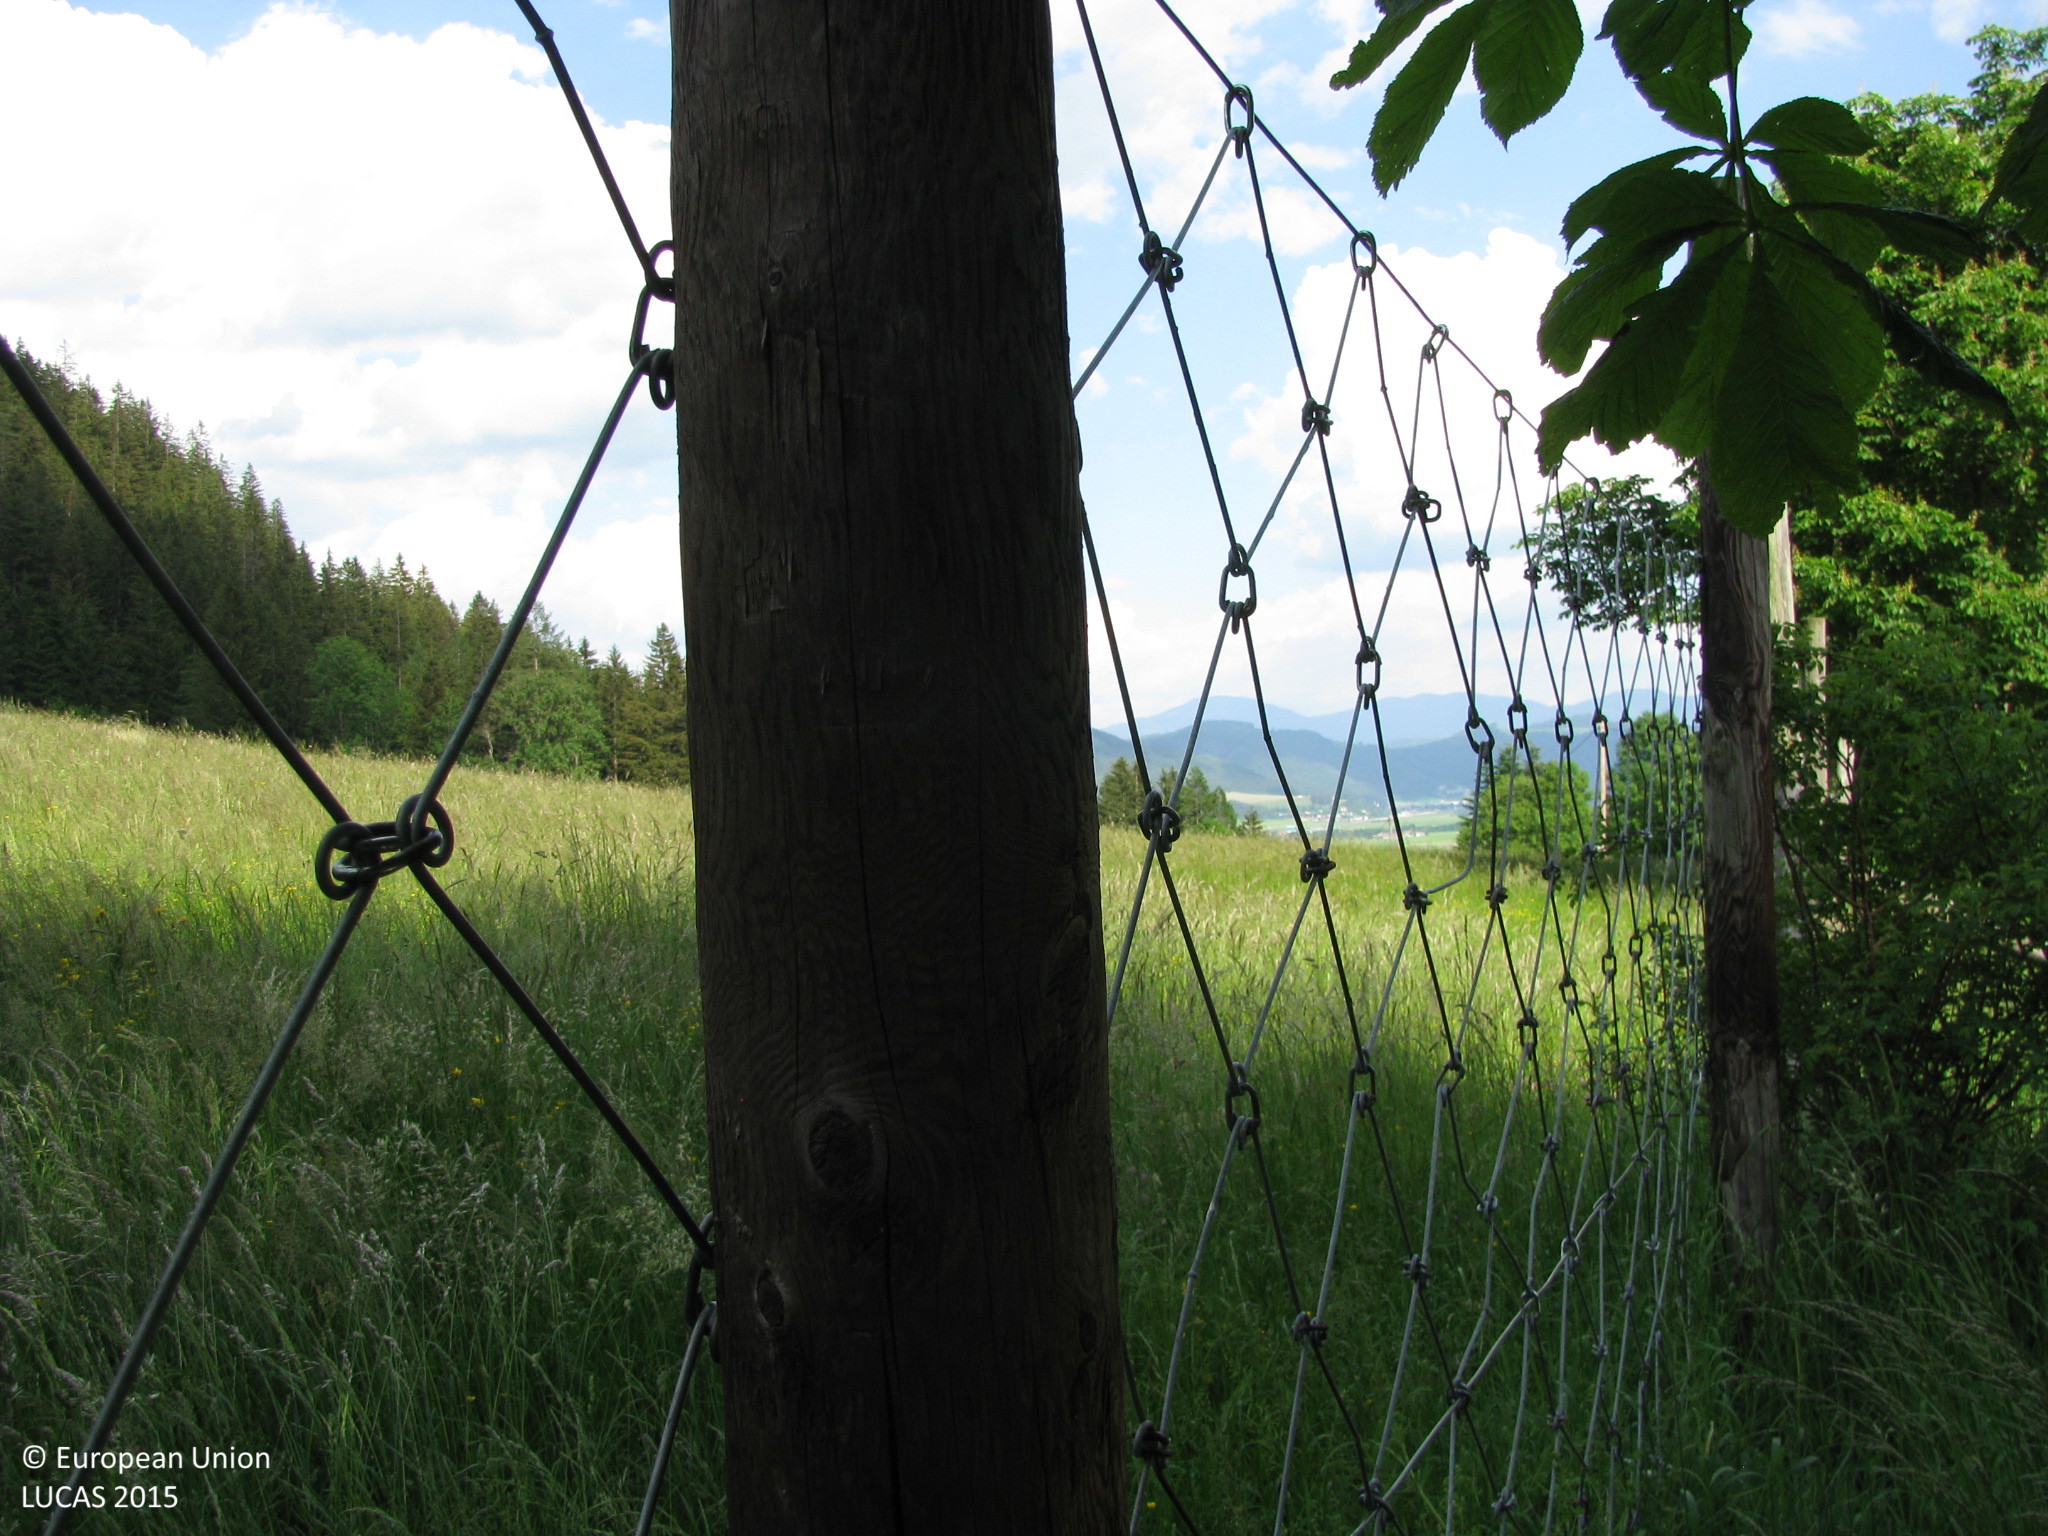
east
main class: Grassland
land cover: Grassland without tree/shrub cover
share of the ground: > 75 %
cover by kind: herbaceous plants 100 %
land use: Agriculture (excluding fallow land and kitchen gardens)
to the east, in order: Grassland without tree/shrub cover; Fences; Spruce dominated coniferous woodland
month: June
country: AT
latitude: 47.3939
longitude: 14.8883
